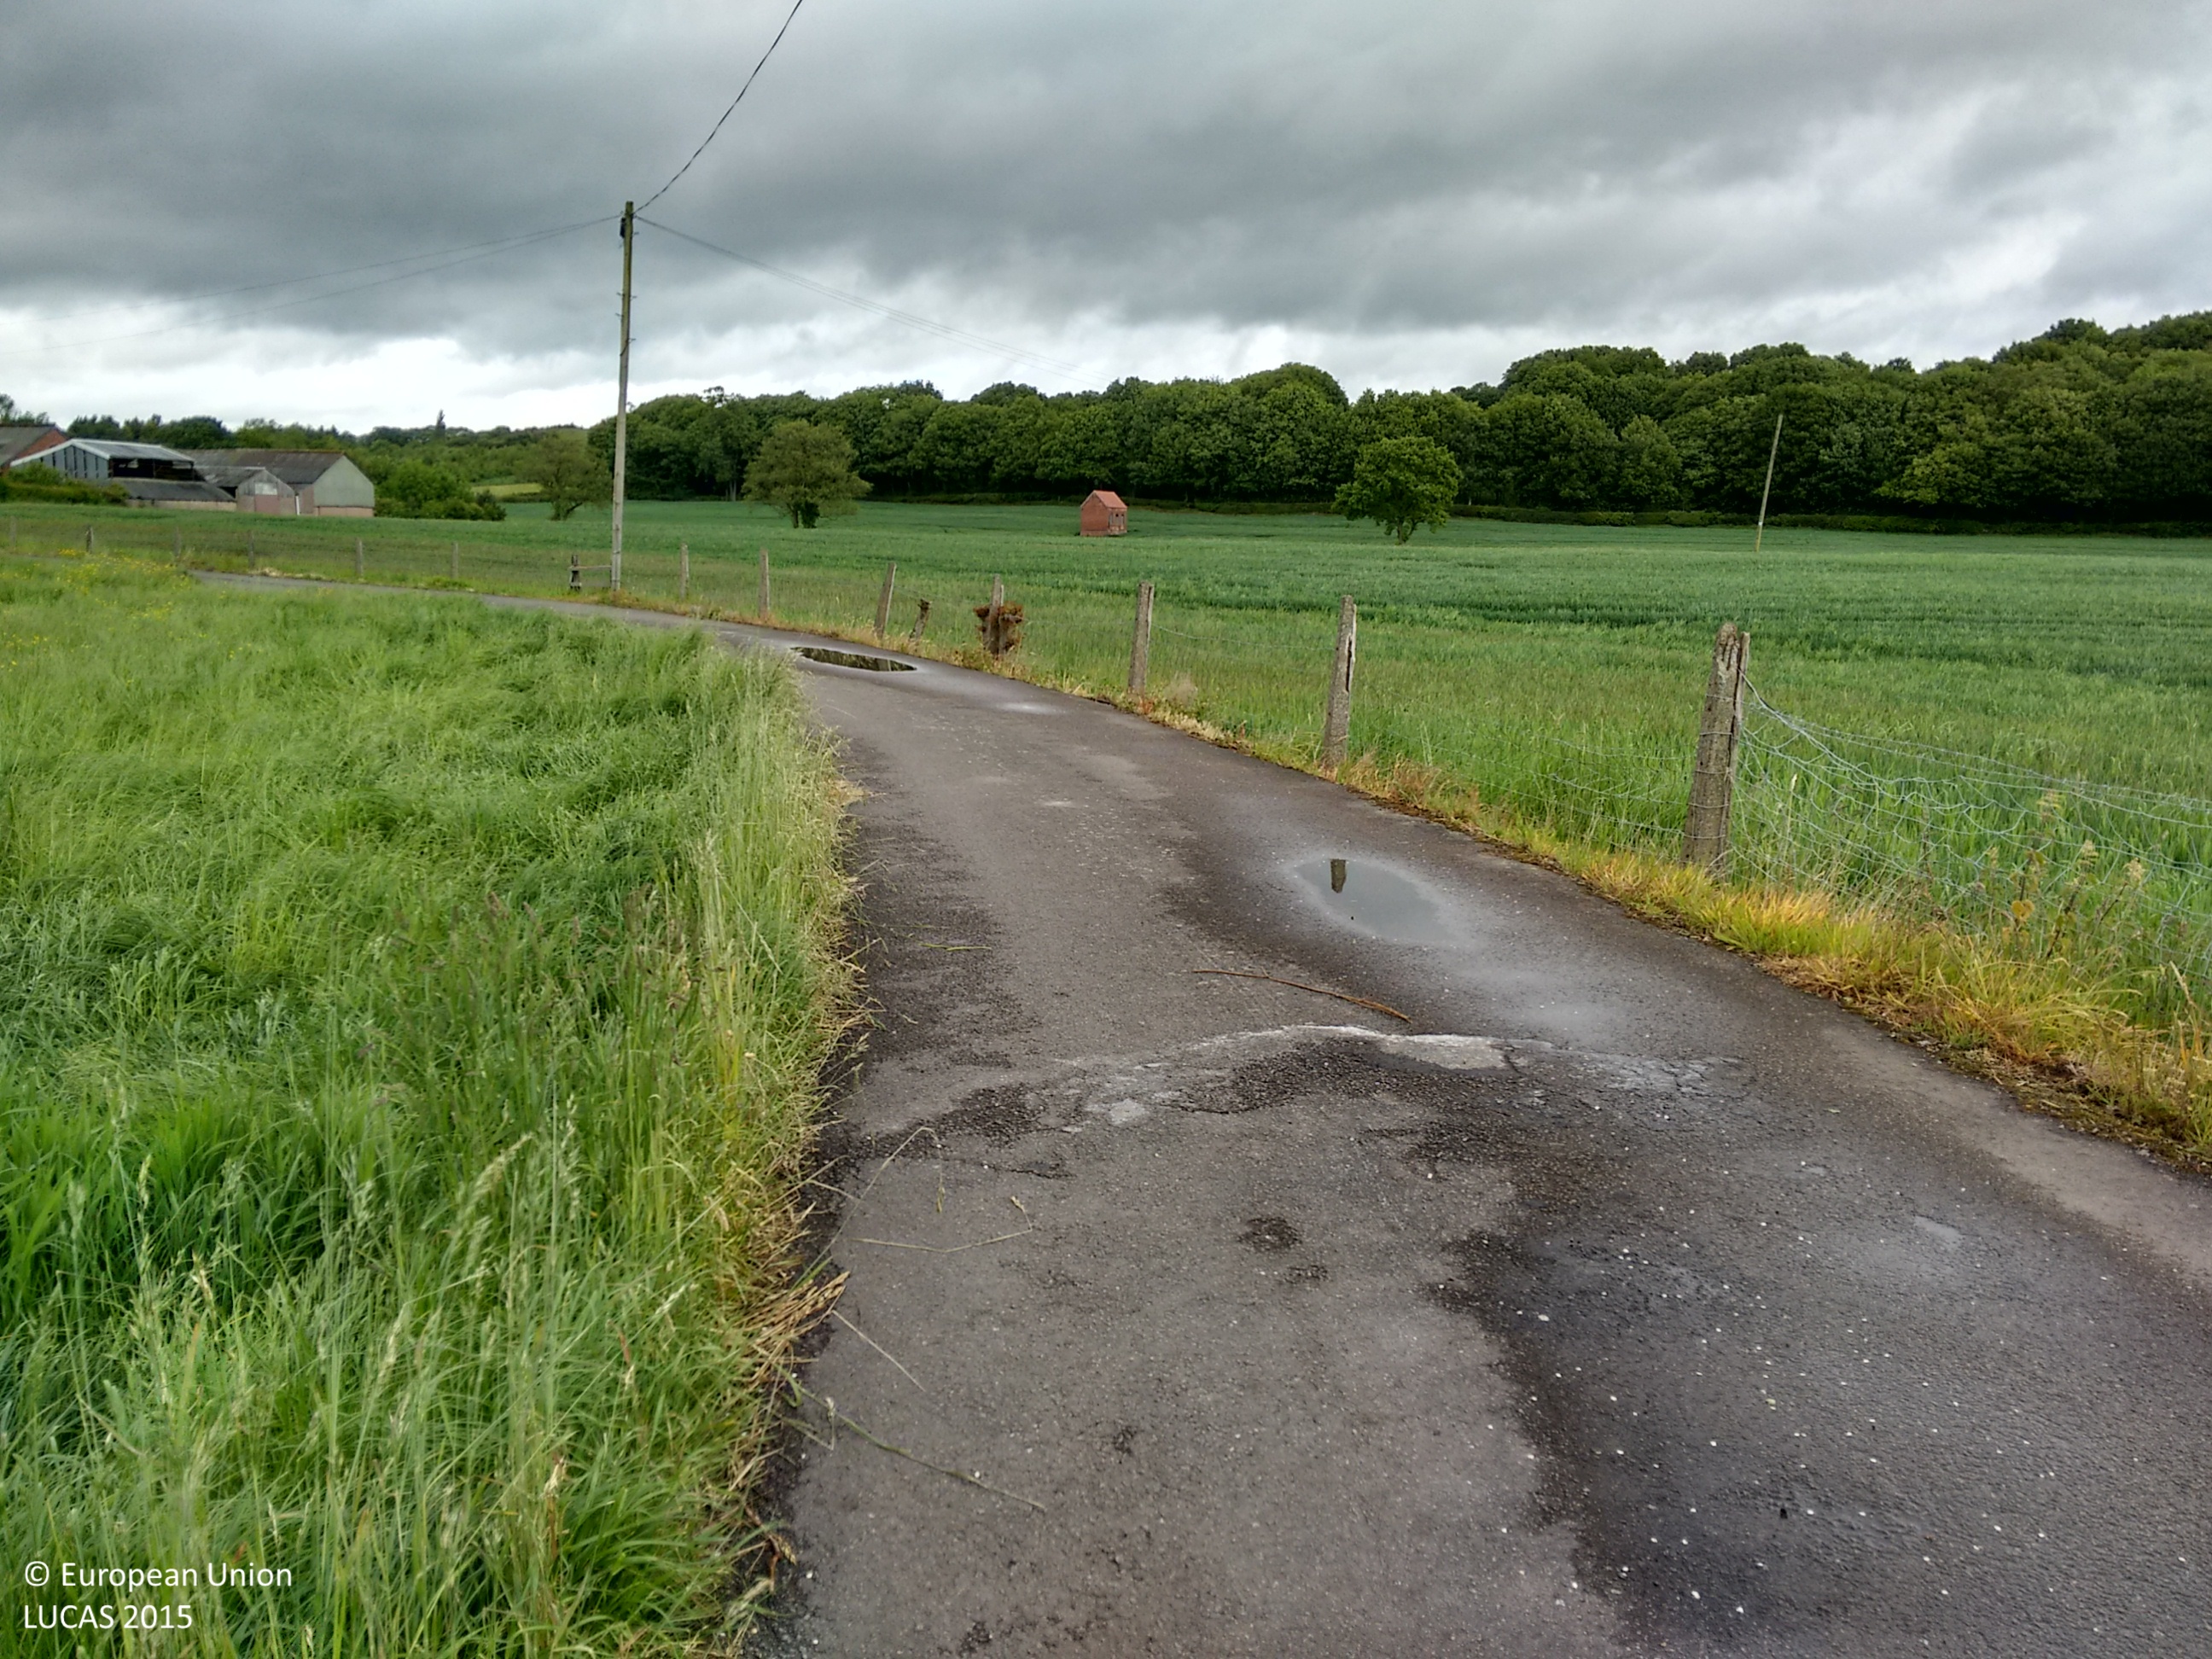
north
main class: Grassland
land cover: Grassland without tree/shrub cover
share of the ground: > 75 %
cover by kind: herbaceous plants 100 %
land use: Agriculture (excluding fallow land and kitchen gardens)
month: June
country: GB
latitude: 52.5395
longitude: -1.5370
